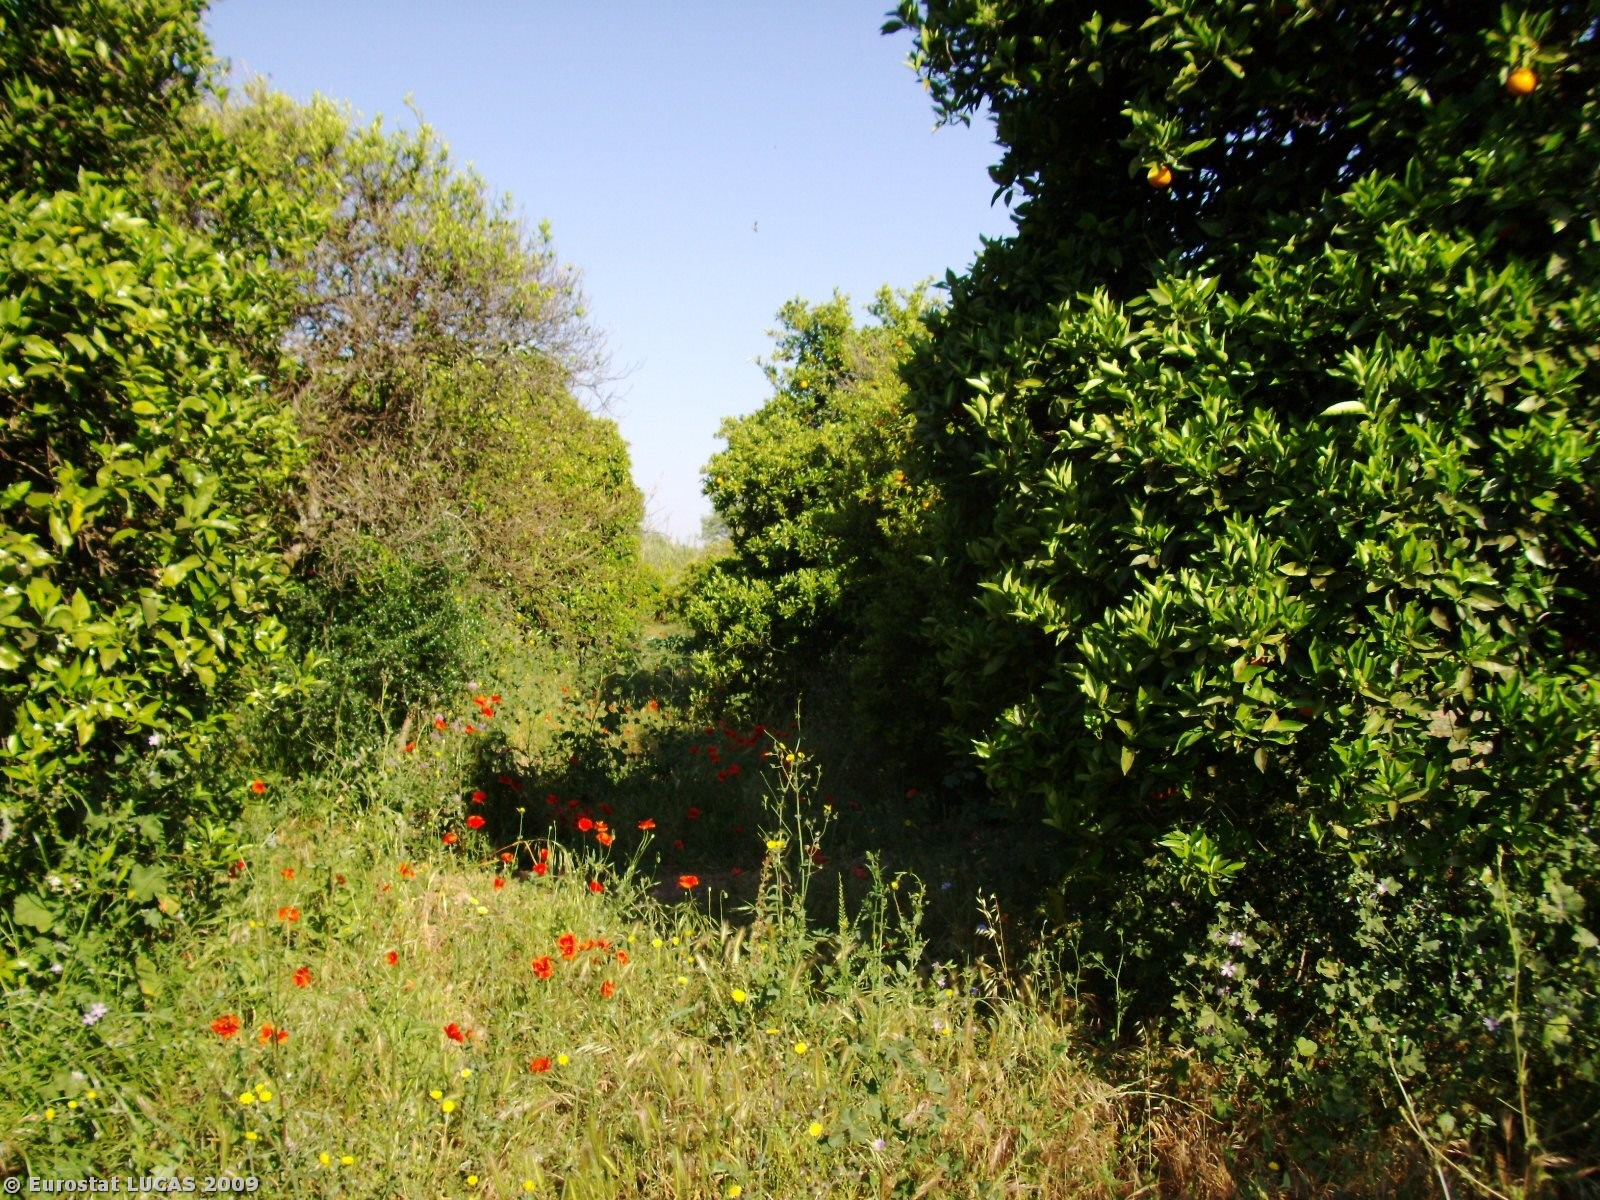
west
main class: Cropland
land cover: Oranges
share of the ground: 50 - 75 %
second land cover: Spontaneously vegetated surfaces
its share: 10 - 25 %
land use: Agriculture (excluding fallow land and kitchen gardens)
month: May
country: PT
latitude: 37.2634
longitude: -7.4703
